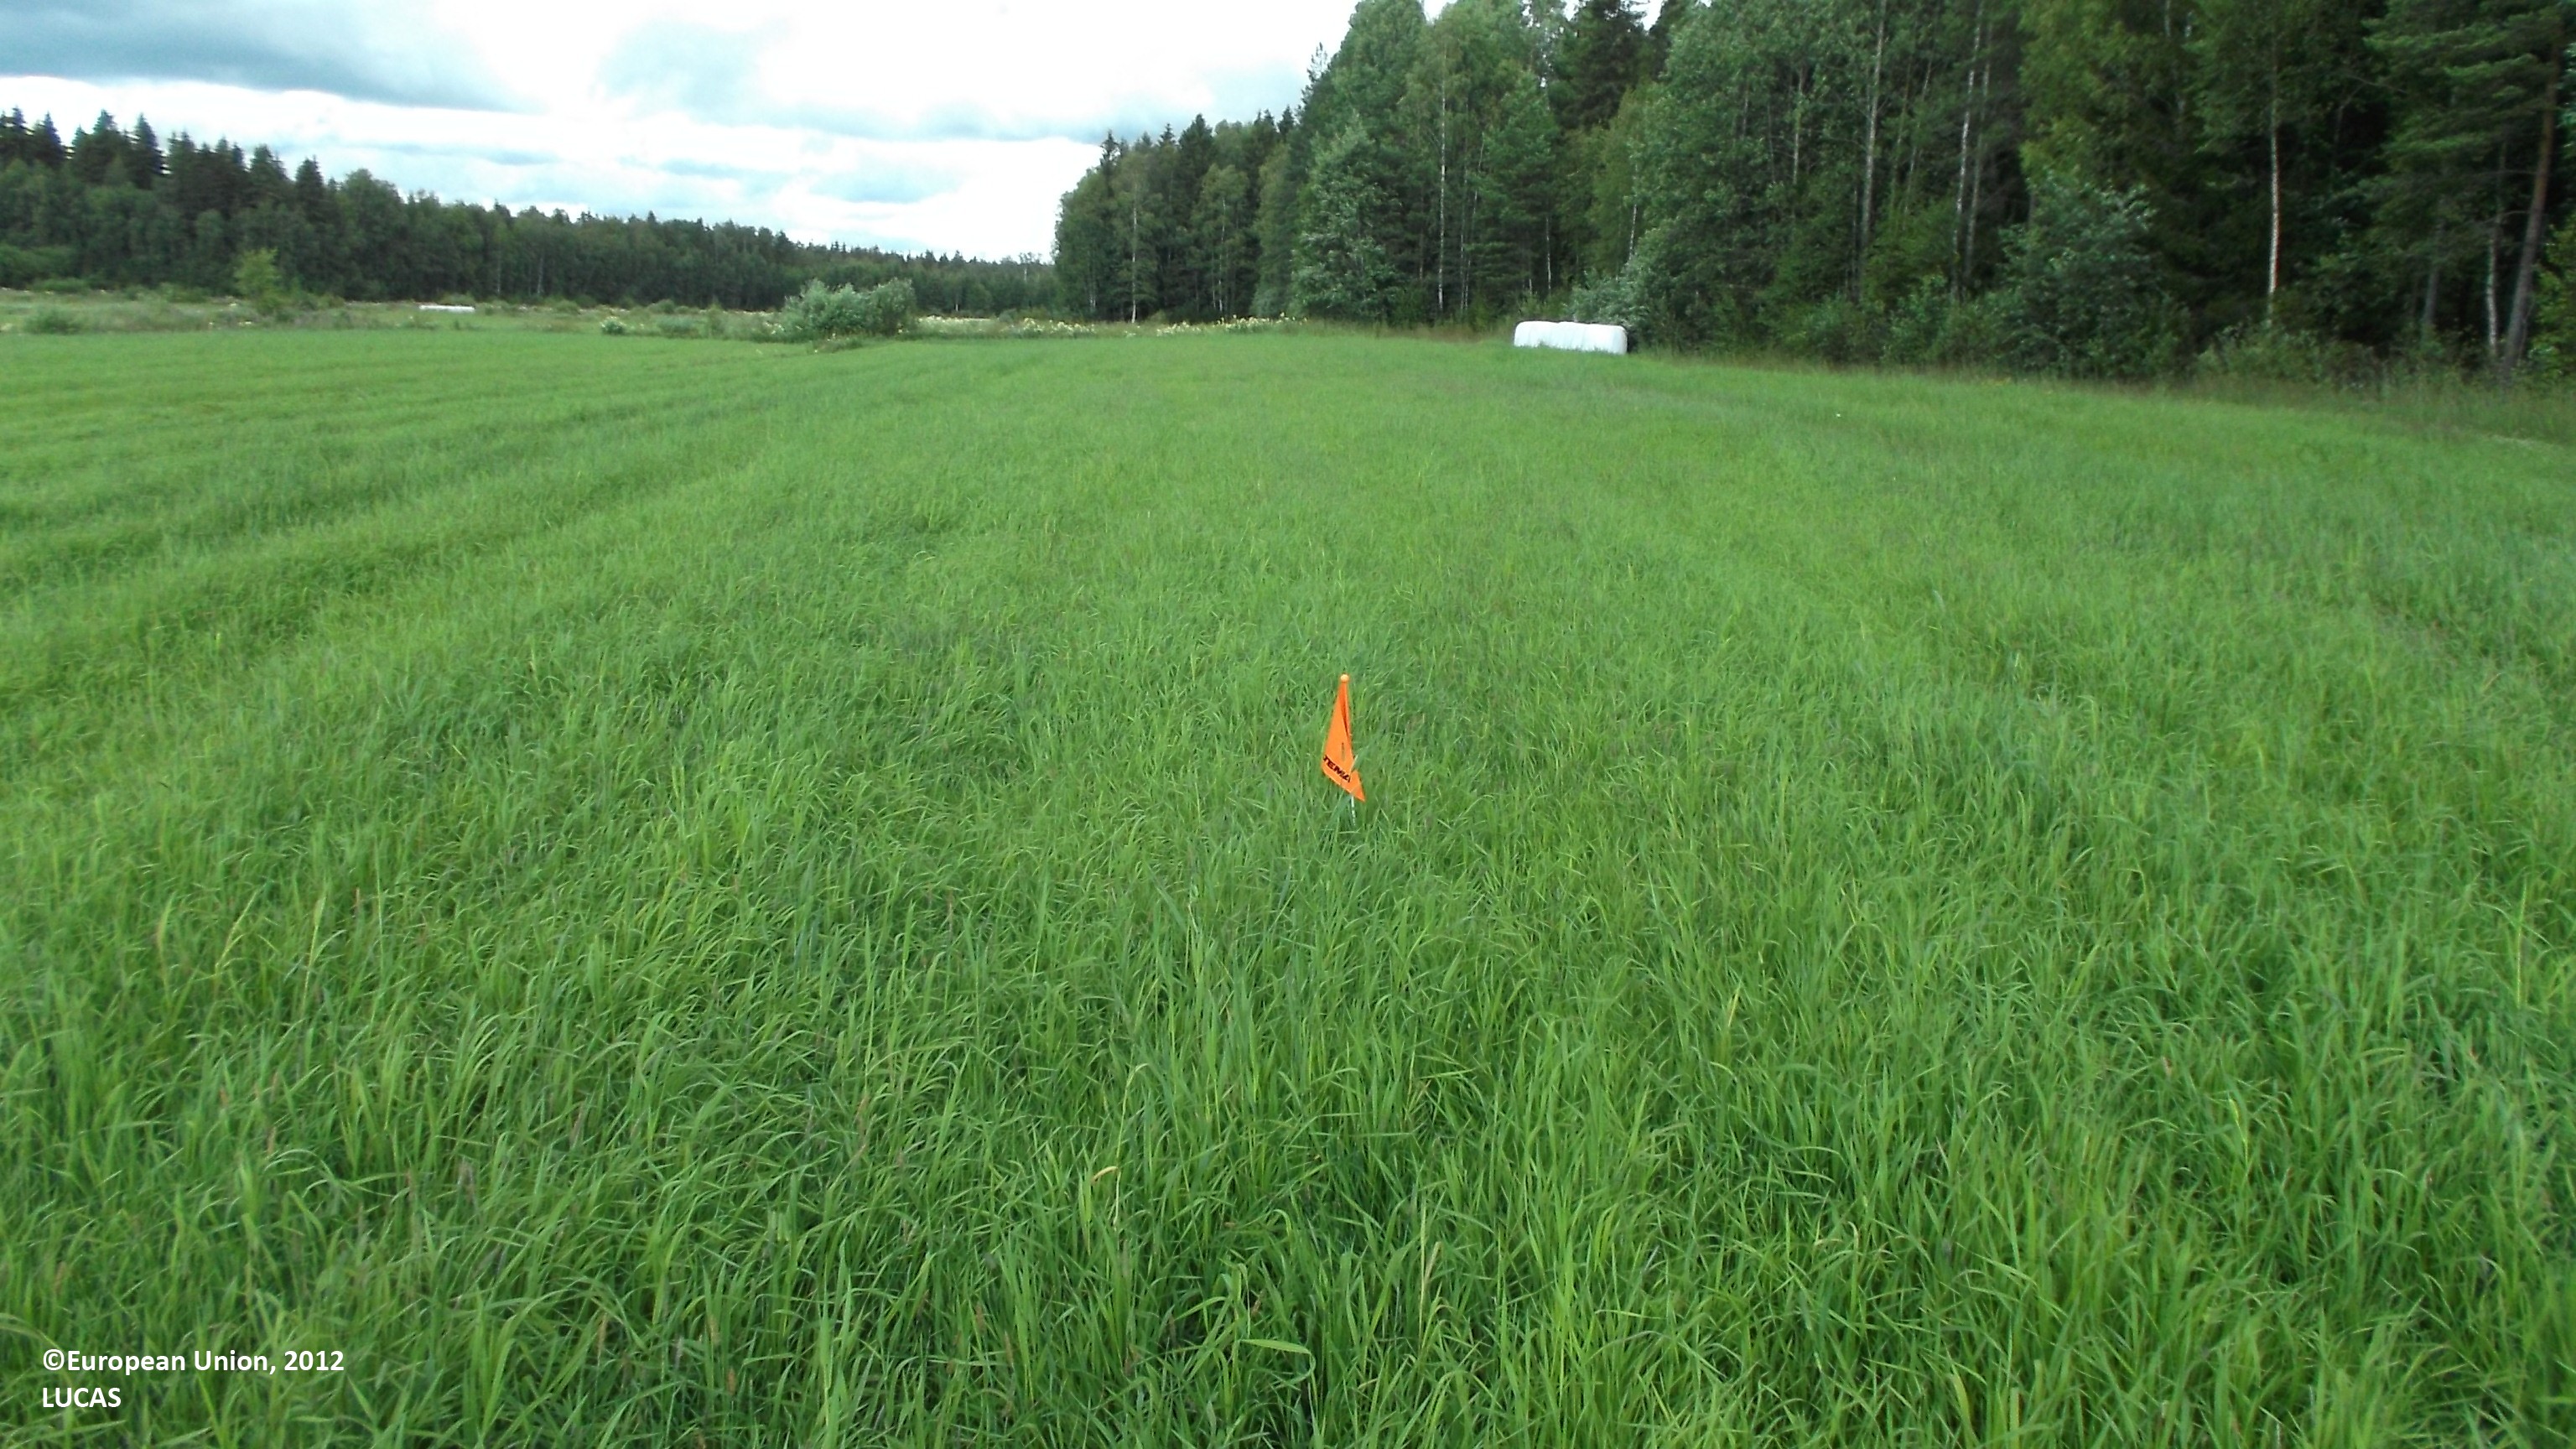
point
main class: Cropland
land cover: Temporary grasslands
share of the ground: > 75 %
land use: Agriculture (excluding fallow land and kitchen gardens)
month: July
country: FI
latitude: 63.6421
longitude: 23.1983
